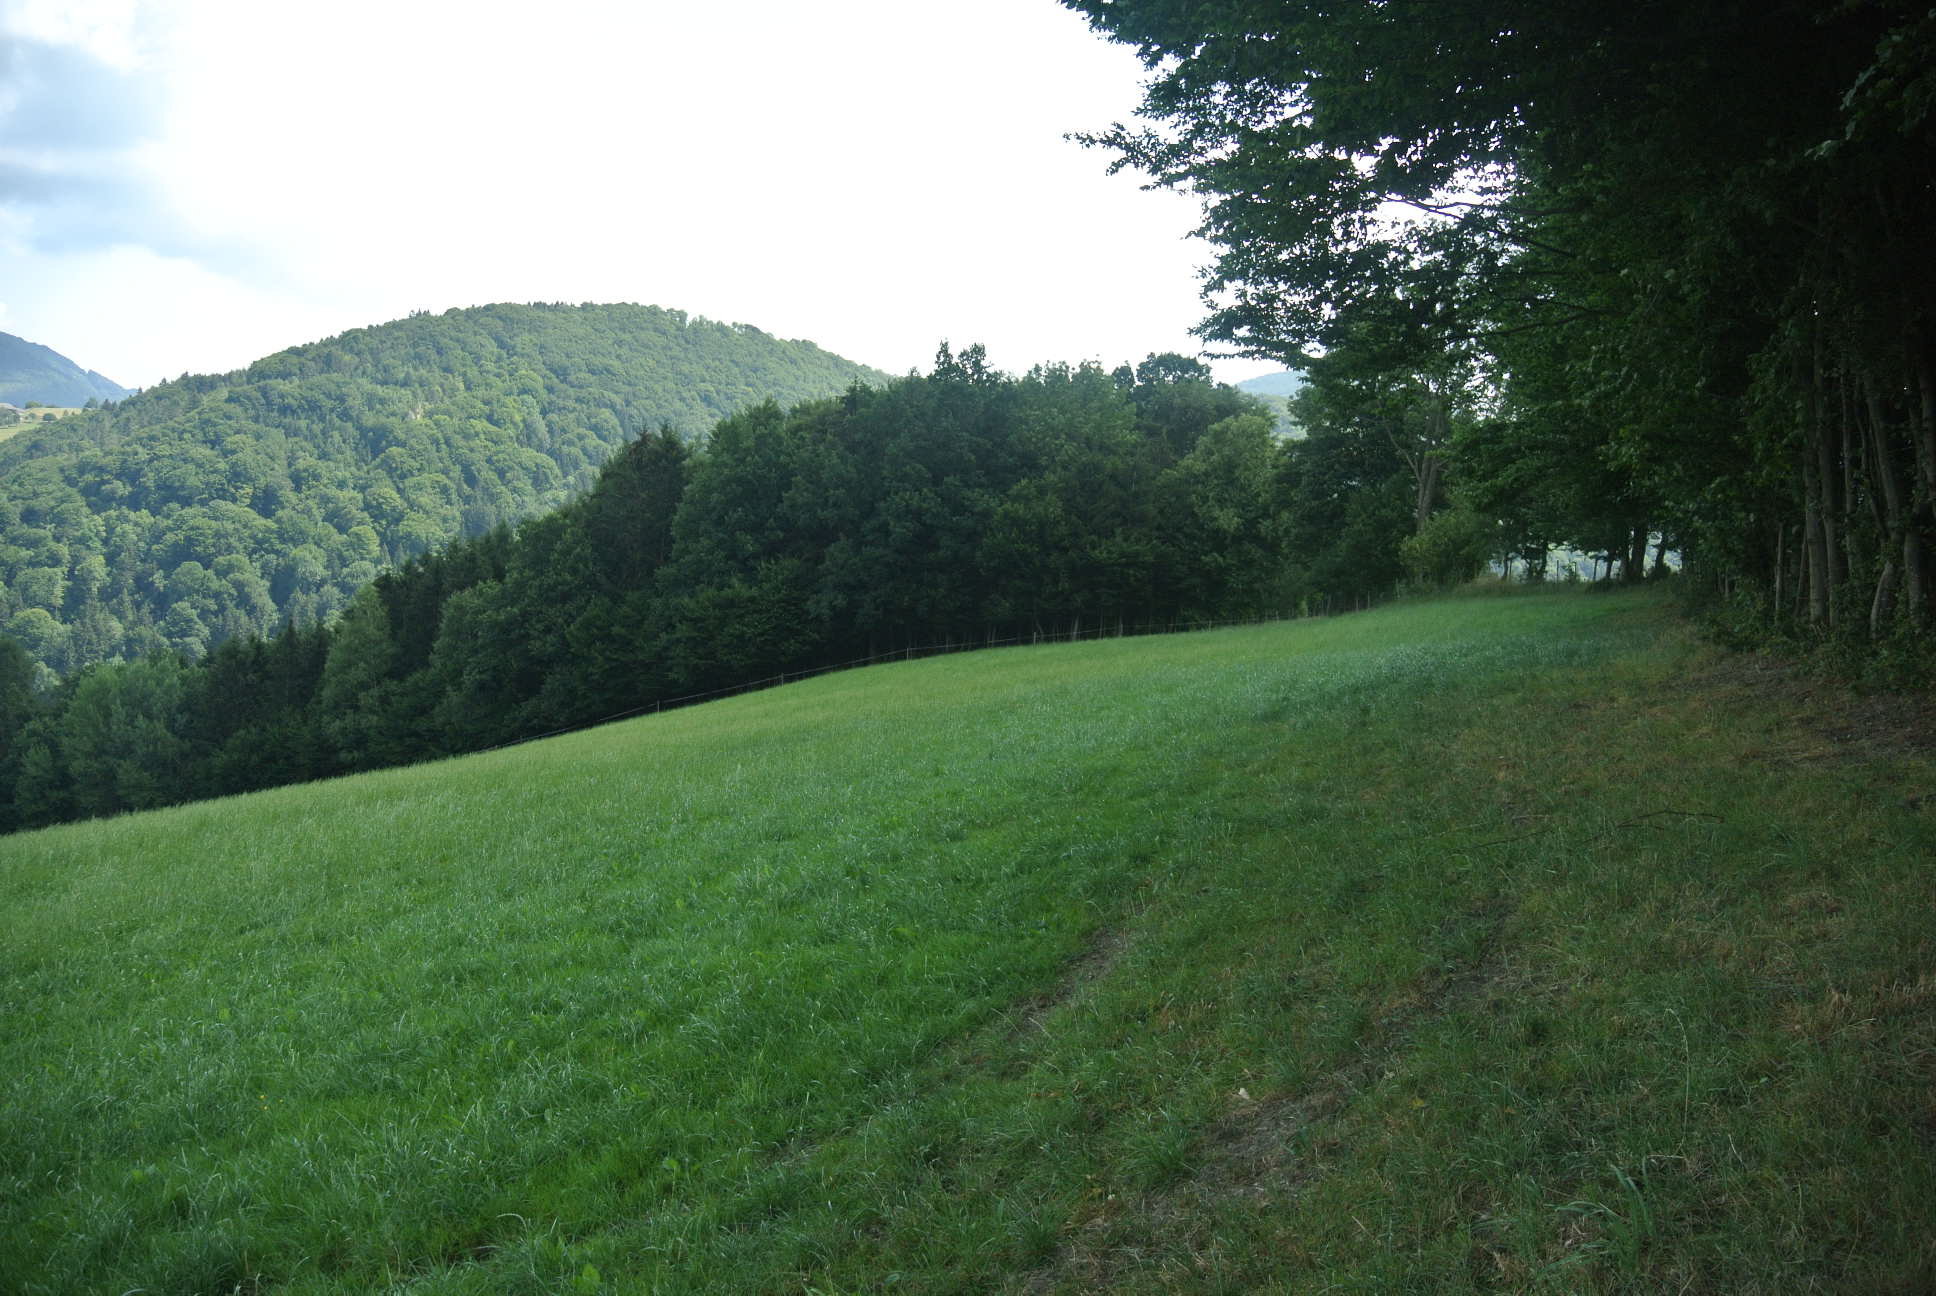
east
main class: Grassland
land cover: Grassland without tree/shrub cover
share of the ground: > 75 %
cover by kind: herbaceous plants 100 %
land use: Agriculture (excluding fallow land and kitchen gardens)
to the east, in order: Grassland without tree/shrub cover; Fences; Spruce dominated coniferous woodland; Grassland without tree/shrub cover; Fences; Grassland without tree/shrub cover; Fences; Grassland without tree/shrub cover; Spruce dominated mixed woodland; Grassland without tree/shrub cover; Fences; Spruce dominated mixed woodland
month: July
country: AT
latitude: 48.0175
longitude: 15.4317
